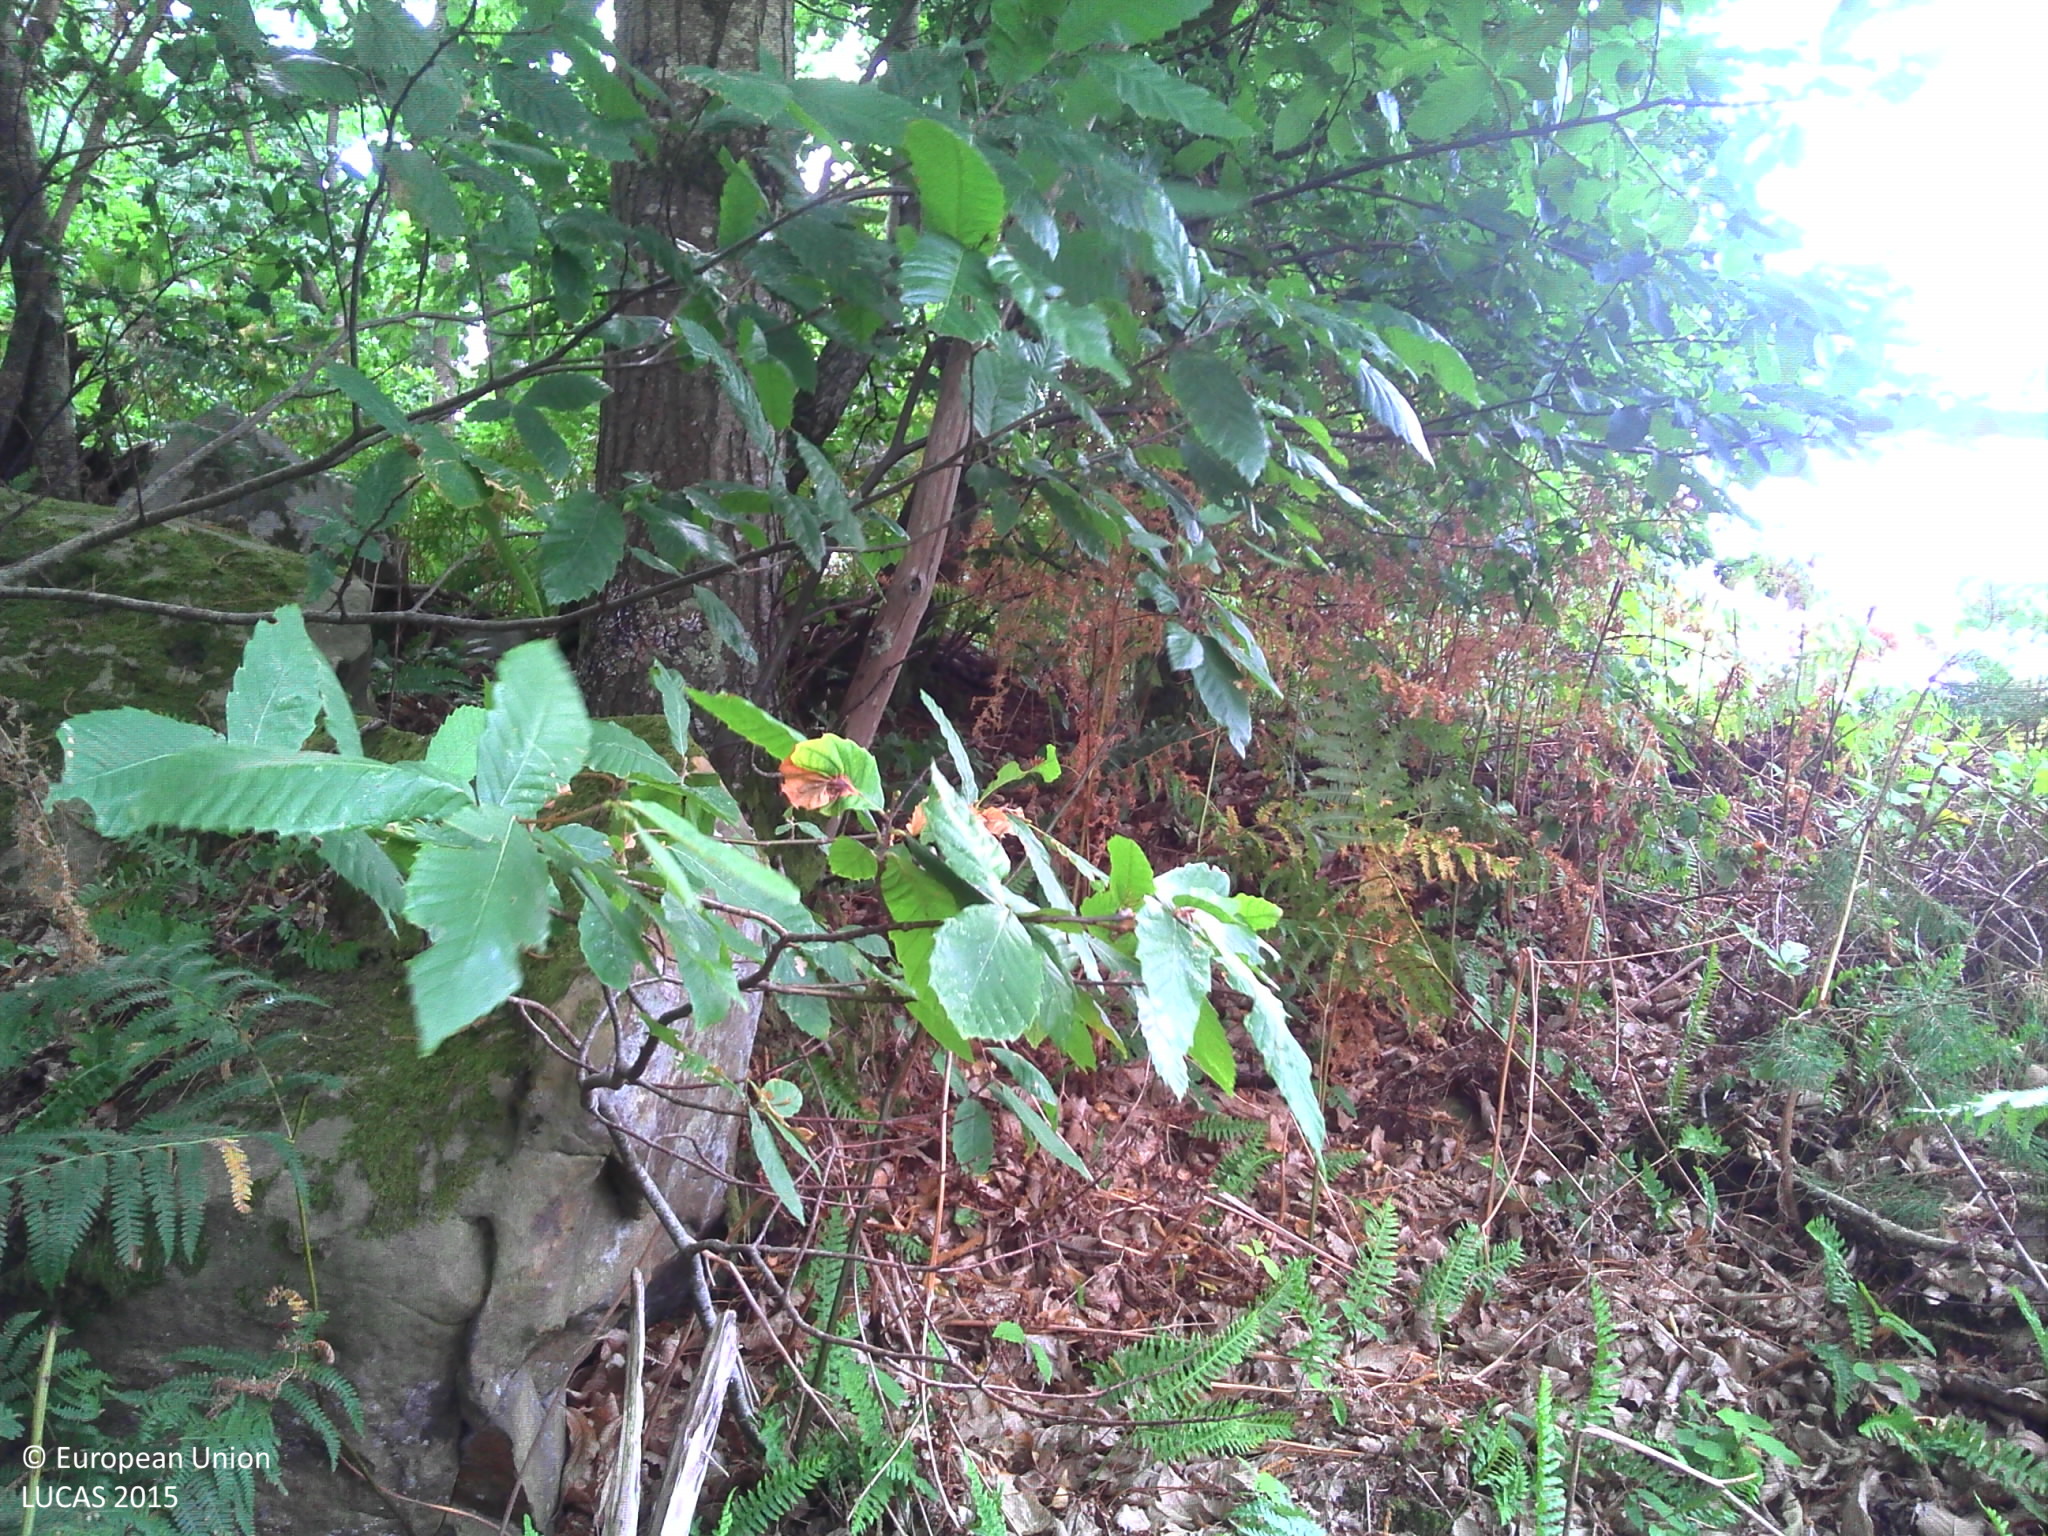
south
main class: Woodland
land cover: Broadleaved woodland
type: thermophilous deciduous forest
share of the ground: > 75 %
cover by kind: broadleaved forest trees 55 %, lichens and mosses 15 %, shrubs 10 %, herbaceous plants 10 %
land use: Forestry
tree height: > 5 m
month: July
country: FR
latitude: 48.4190
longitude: 2.7618
